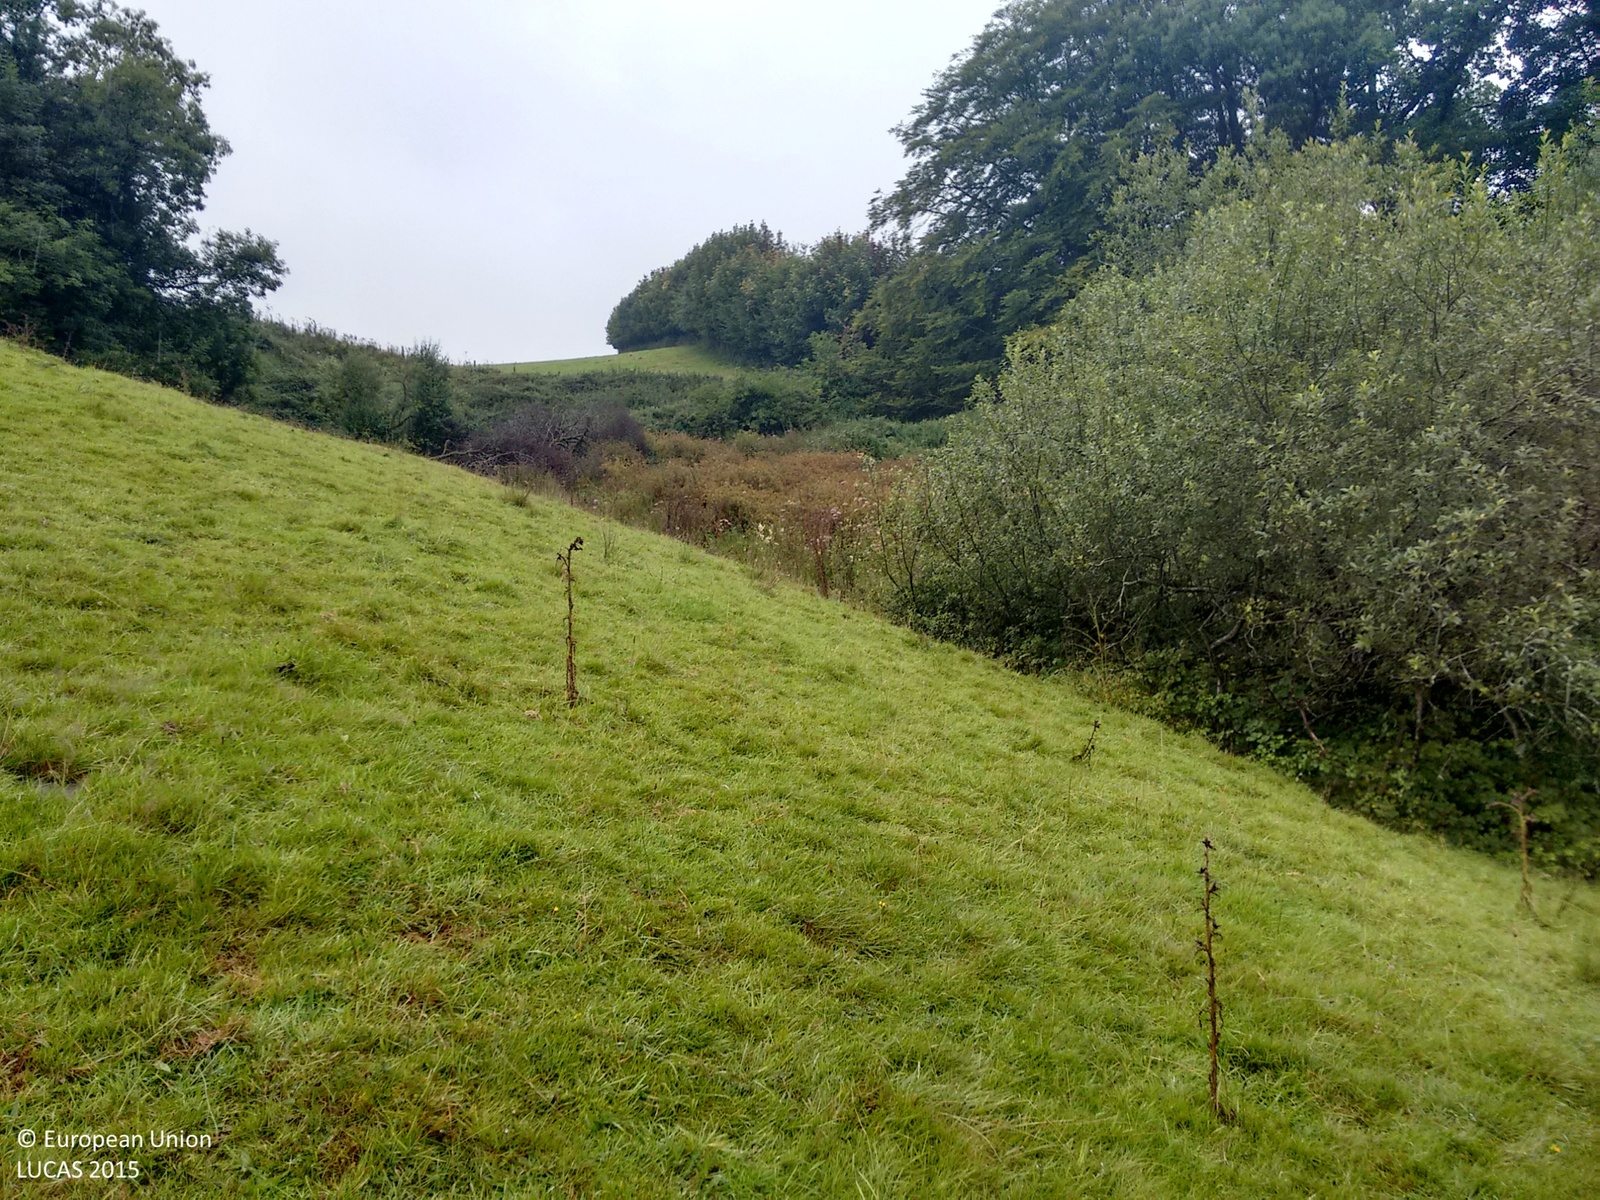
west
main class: Grassland
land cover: Grassland without tree/shrub cover
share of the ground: > 75 %
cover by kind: herbaceous plants 100 %
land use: Agriculture (excluding fallow land and kitchen gardens)
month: August
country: GB
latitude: 51.0854
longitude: -3.5474
